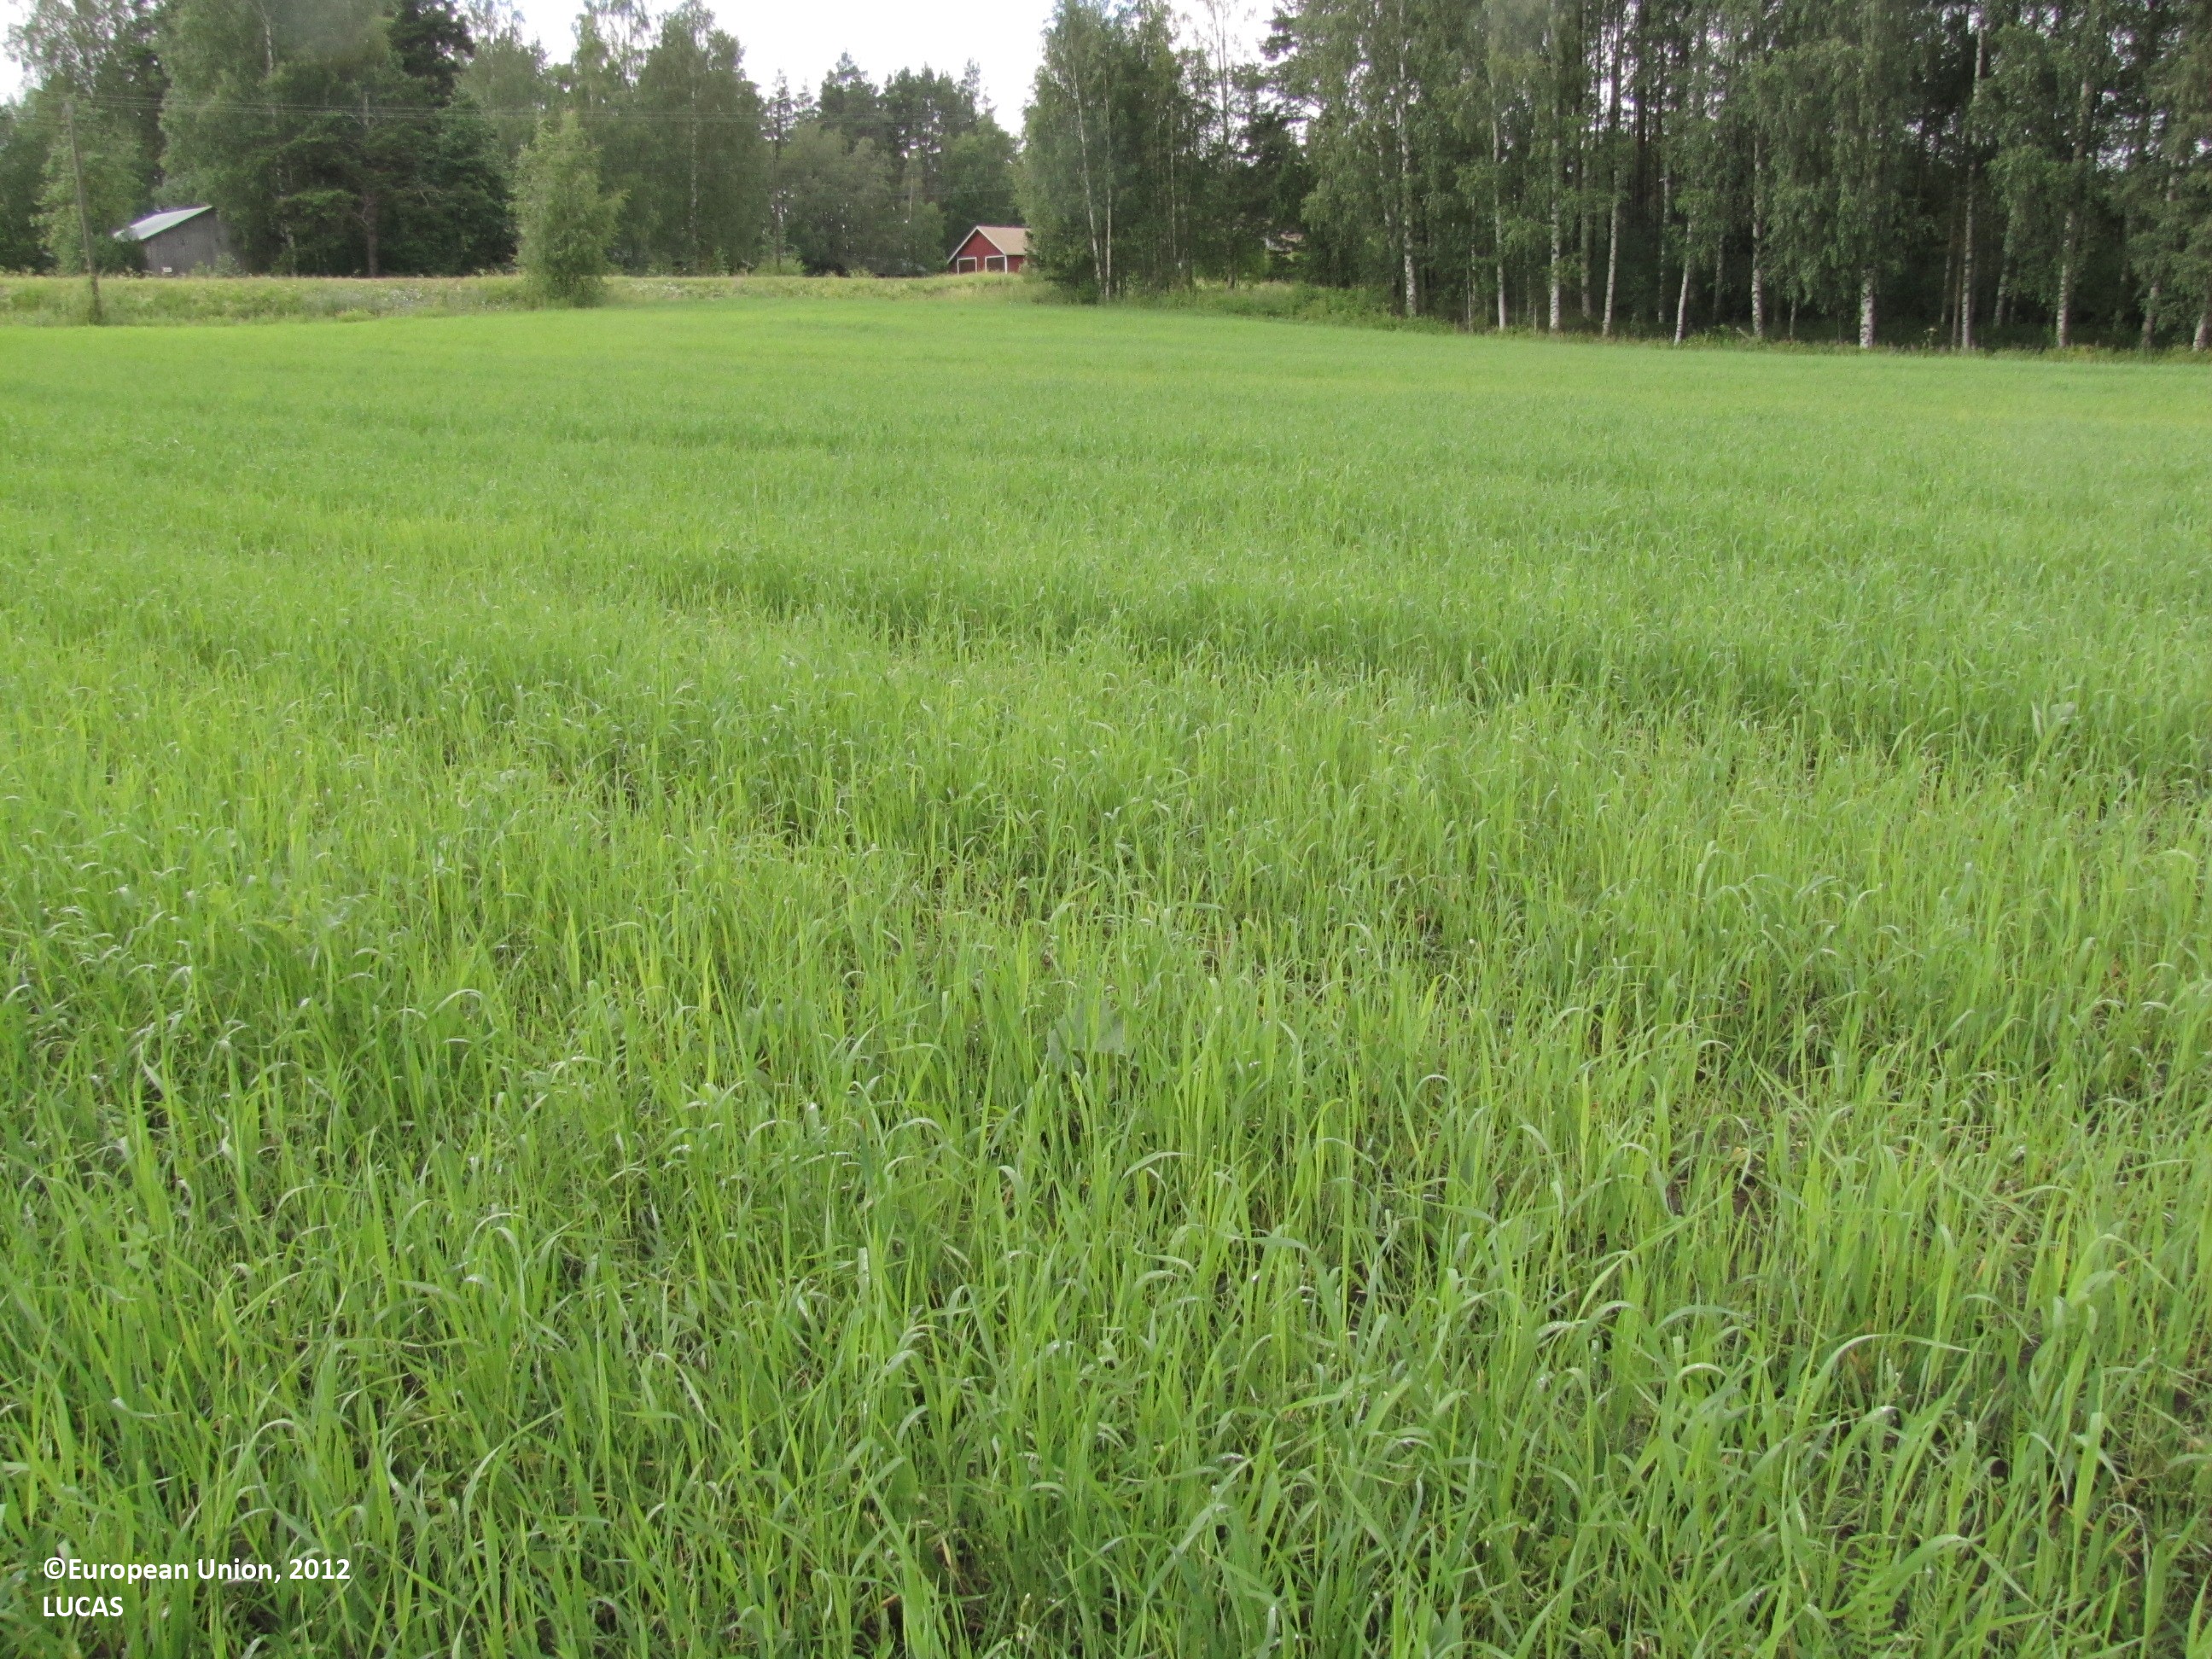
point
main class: Cropland
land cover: Oats
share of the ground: 50 - 75 %
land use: Agriculture (excluding fallow land and kitchen gardens)
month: July
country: FI
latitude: 62.3103
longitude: 23.3221
